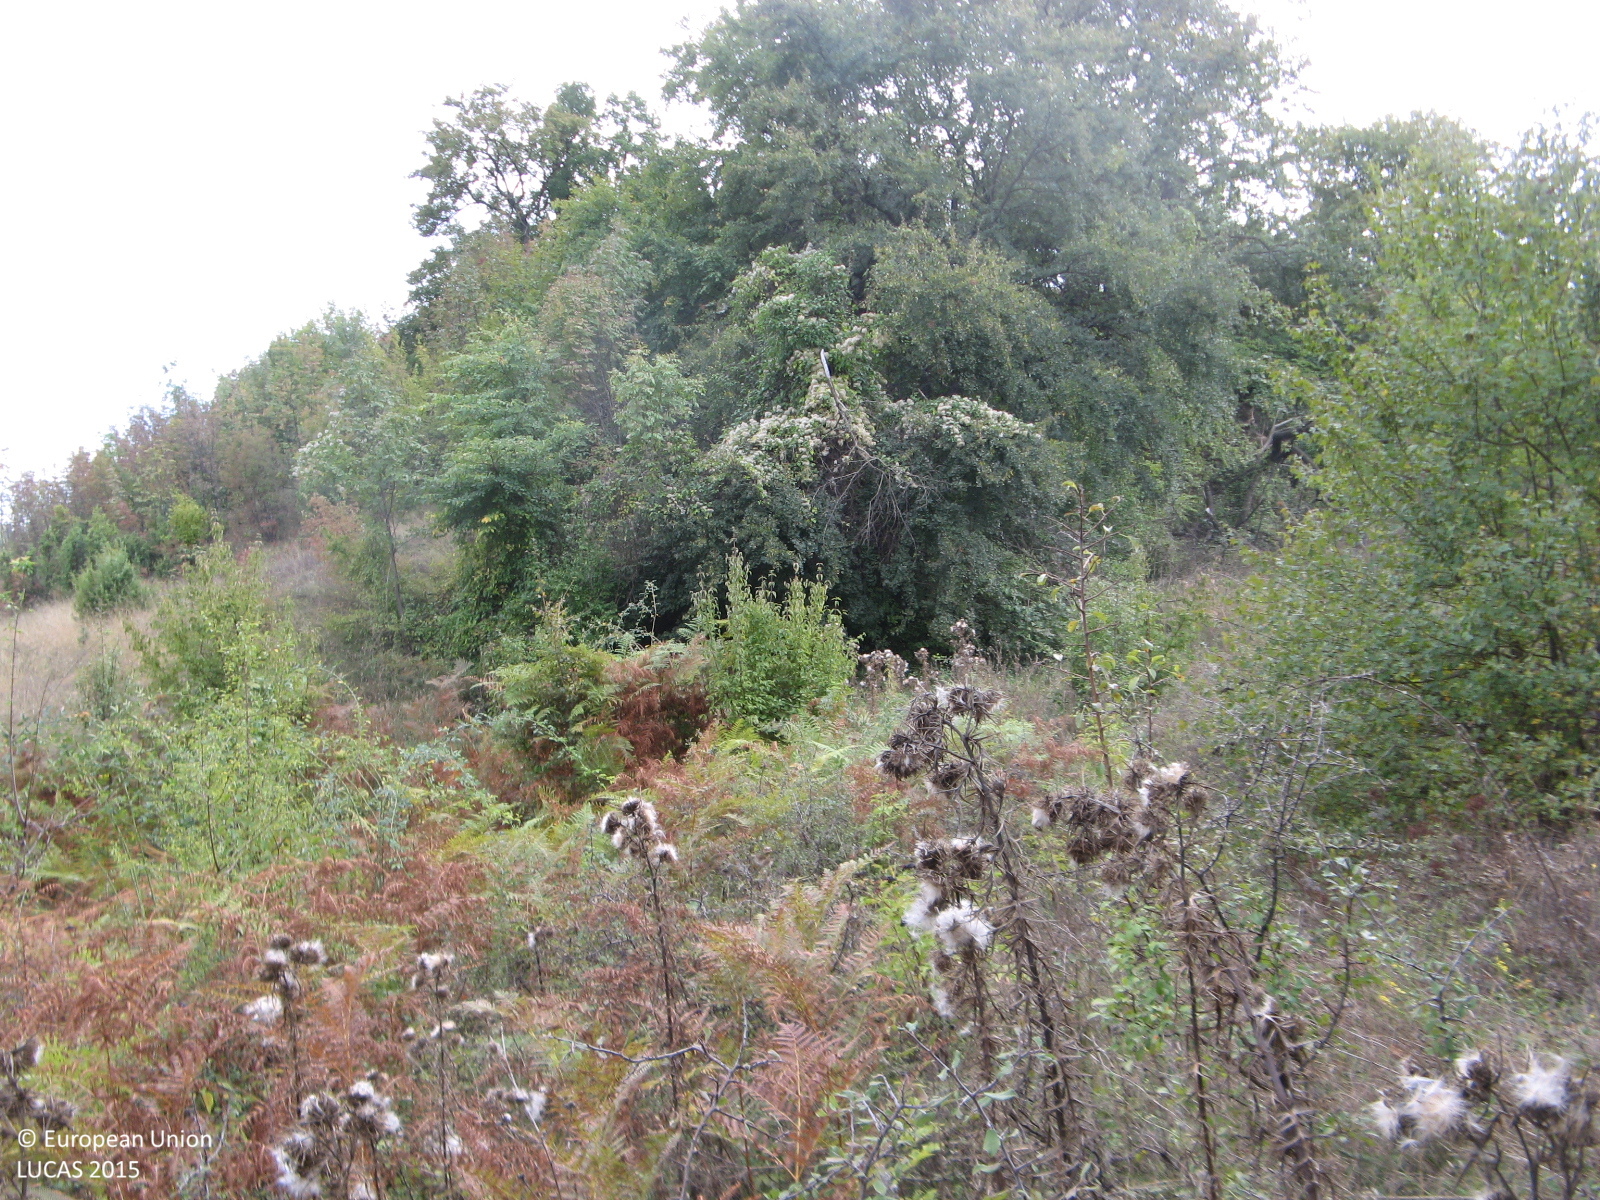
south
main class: Woodland
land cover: Broadleaved woodland
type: thermophilous deciduous forest
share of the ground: > 75 %
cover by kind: broadleaved forest trees 85 %, shrubs 10 %, herbaceous plants 5 %
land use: Semi-natural and natural areas not in use
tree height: > 5 m
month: October
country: BG
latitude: 41.7133
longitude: 25.3577
